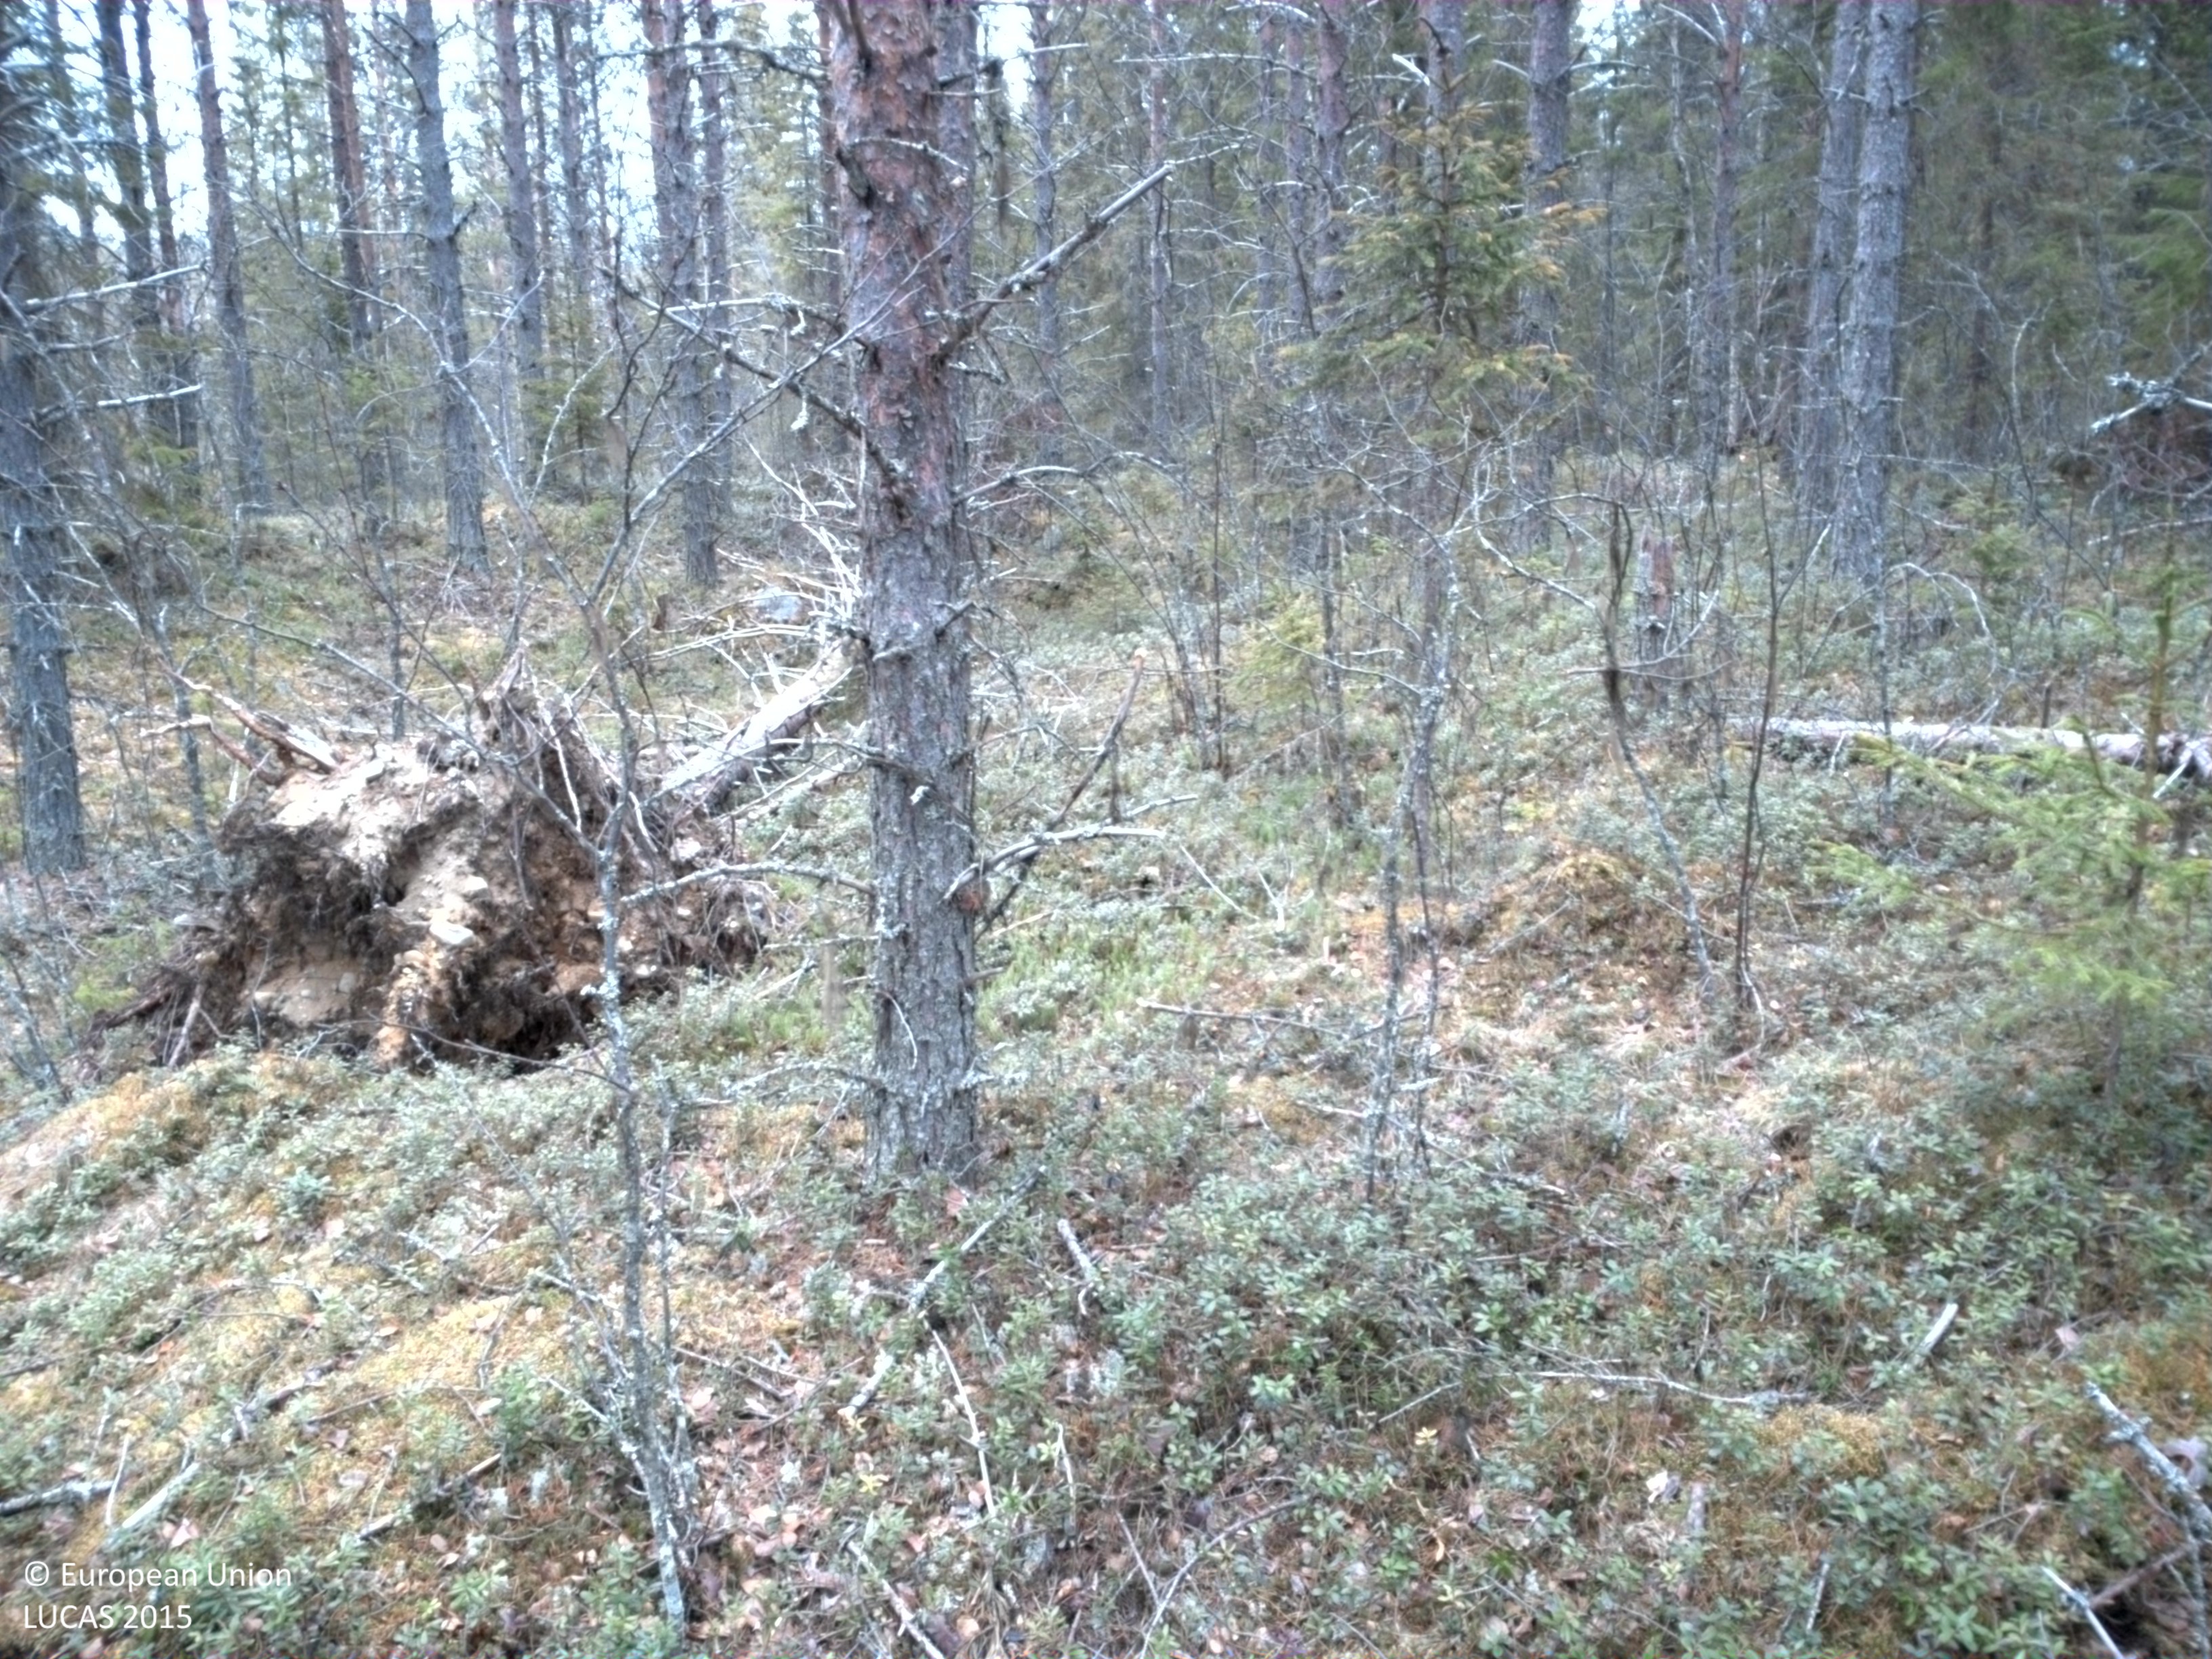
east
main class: Woodland
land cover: Pine dominated coniferous woodland
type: boreal forest
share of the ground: 25 - 50 %
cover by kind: coniferous forest trees 40 %, lichens and mosses 30 %, herbaceous plants 20 %, broadleaved forest trees 10 %
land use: Forestry
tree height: > 5 m
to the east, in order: Pine dominated coniferous woodland; Spruce dominated mixed woodland; Spruce dominated coniferous woodland; Inland marshes; Pine dominated coniferous woodland
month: May
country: SE
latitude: 64.2943
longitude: 18.2141
